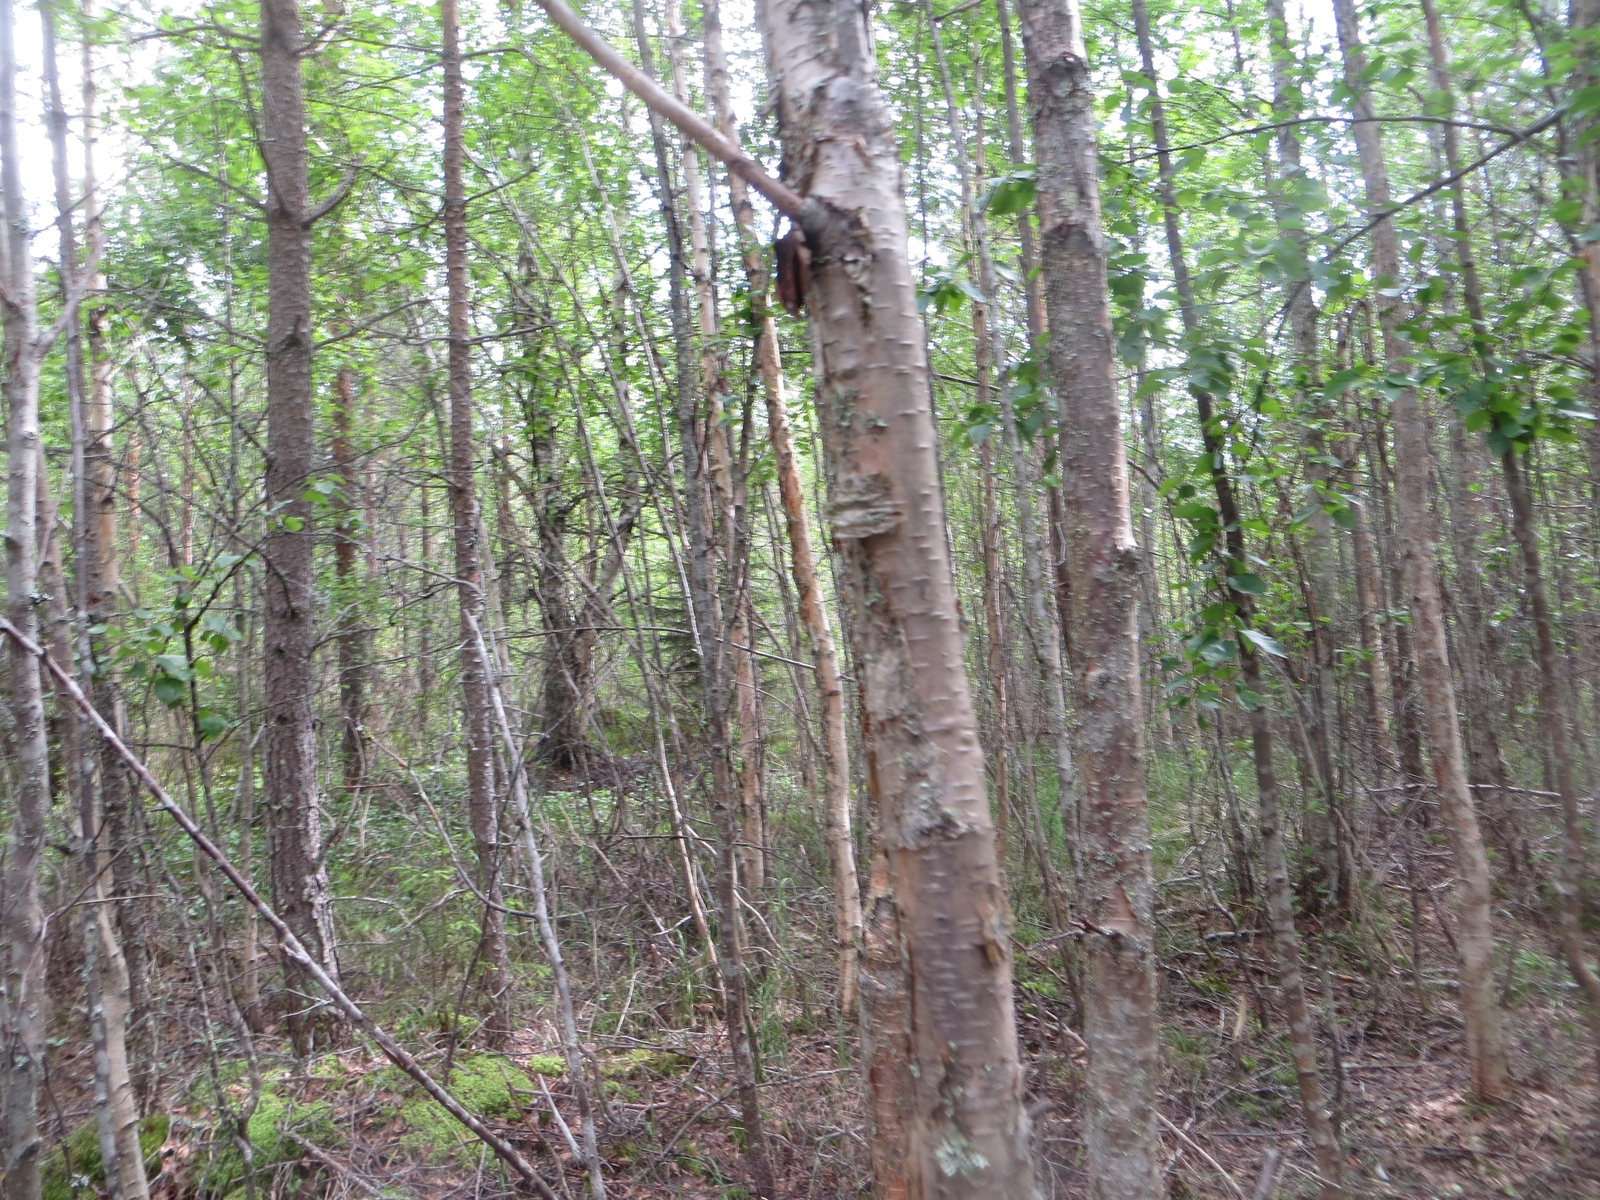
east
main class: Woodland
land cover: Pine dominated mixed woodland
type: boreal forest
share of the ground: > 75 %
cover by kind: broadleaved forest trees 50 %, coniferous forest trees 35 %, shrubs 15 %
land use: Forestry
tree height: > 5 m
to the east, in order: Pine dominated mixed woodland; Broadleaved woodland; Ditches and canals; Broadleaved woodland; Ditches and canals; Broadleaved woodland
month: July
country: FI
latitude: 65.4283
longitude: 25.8407
